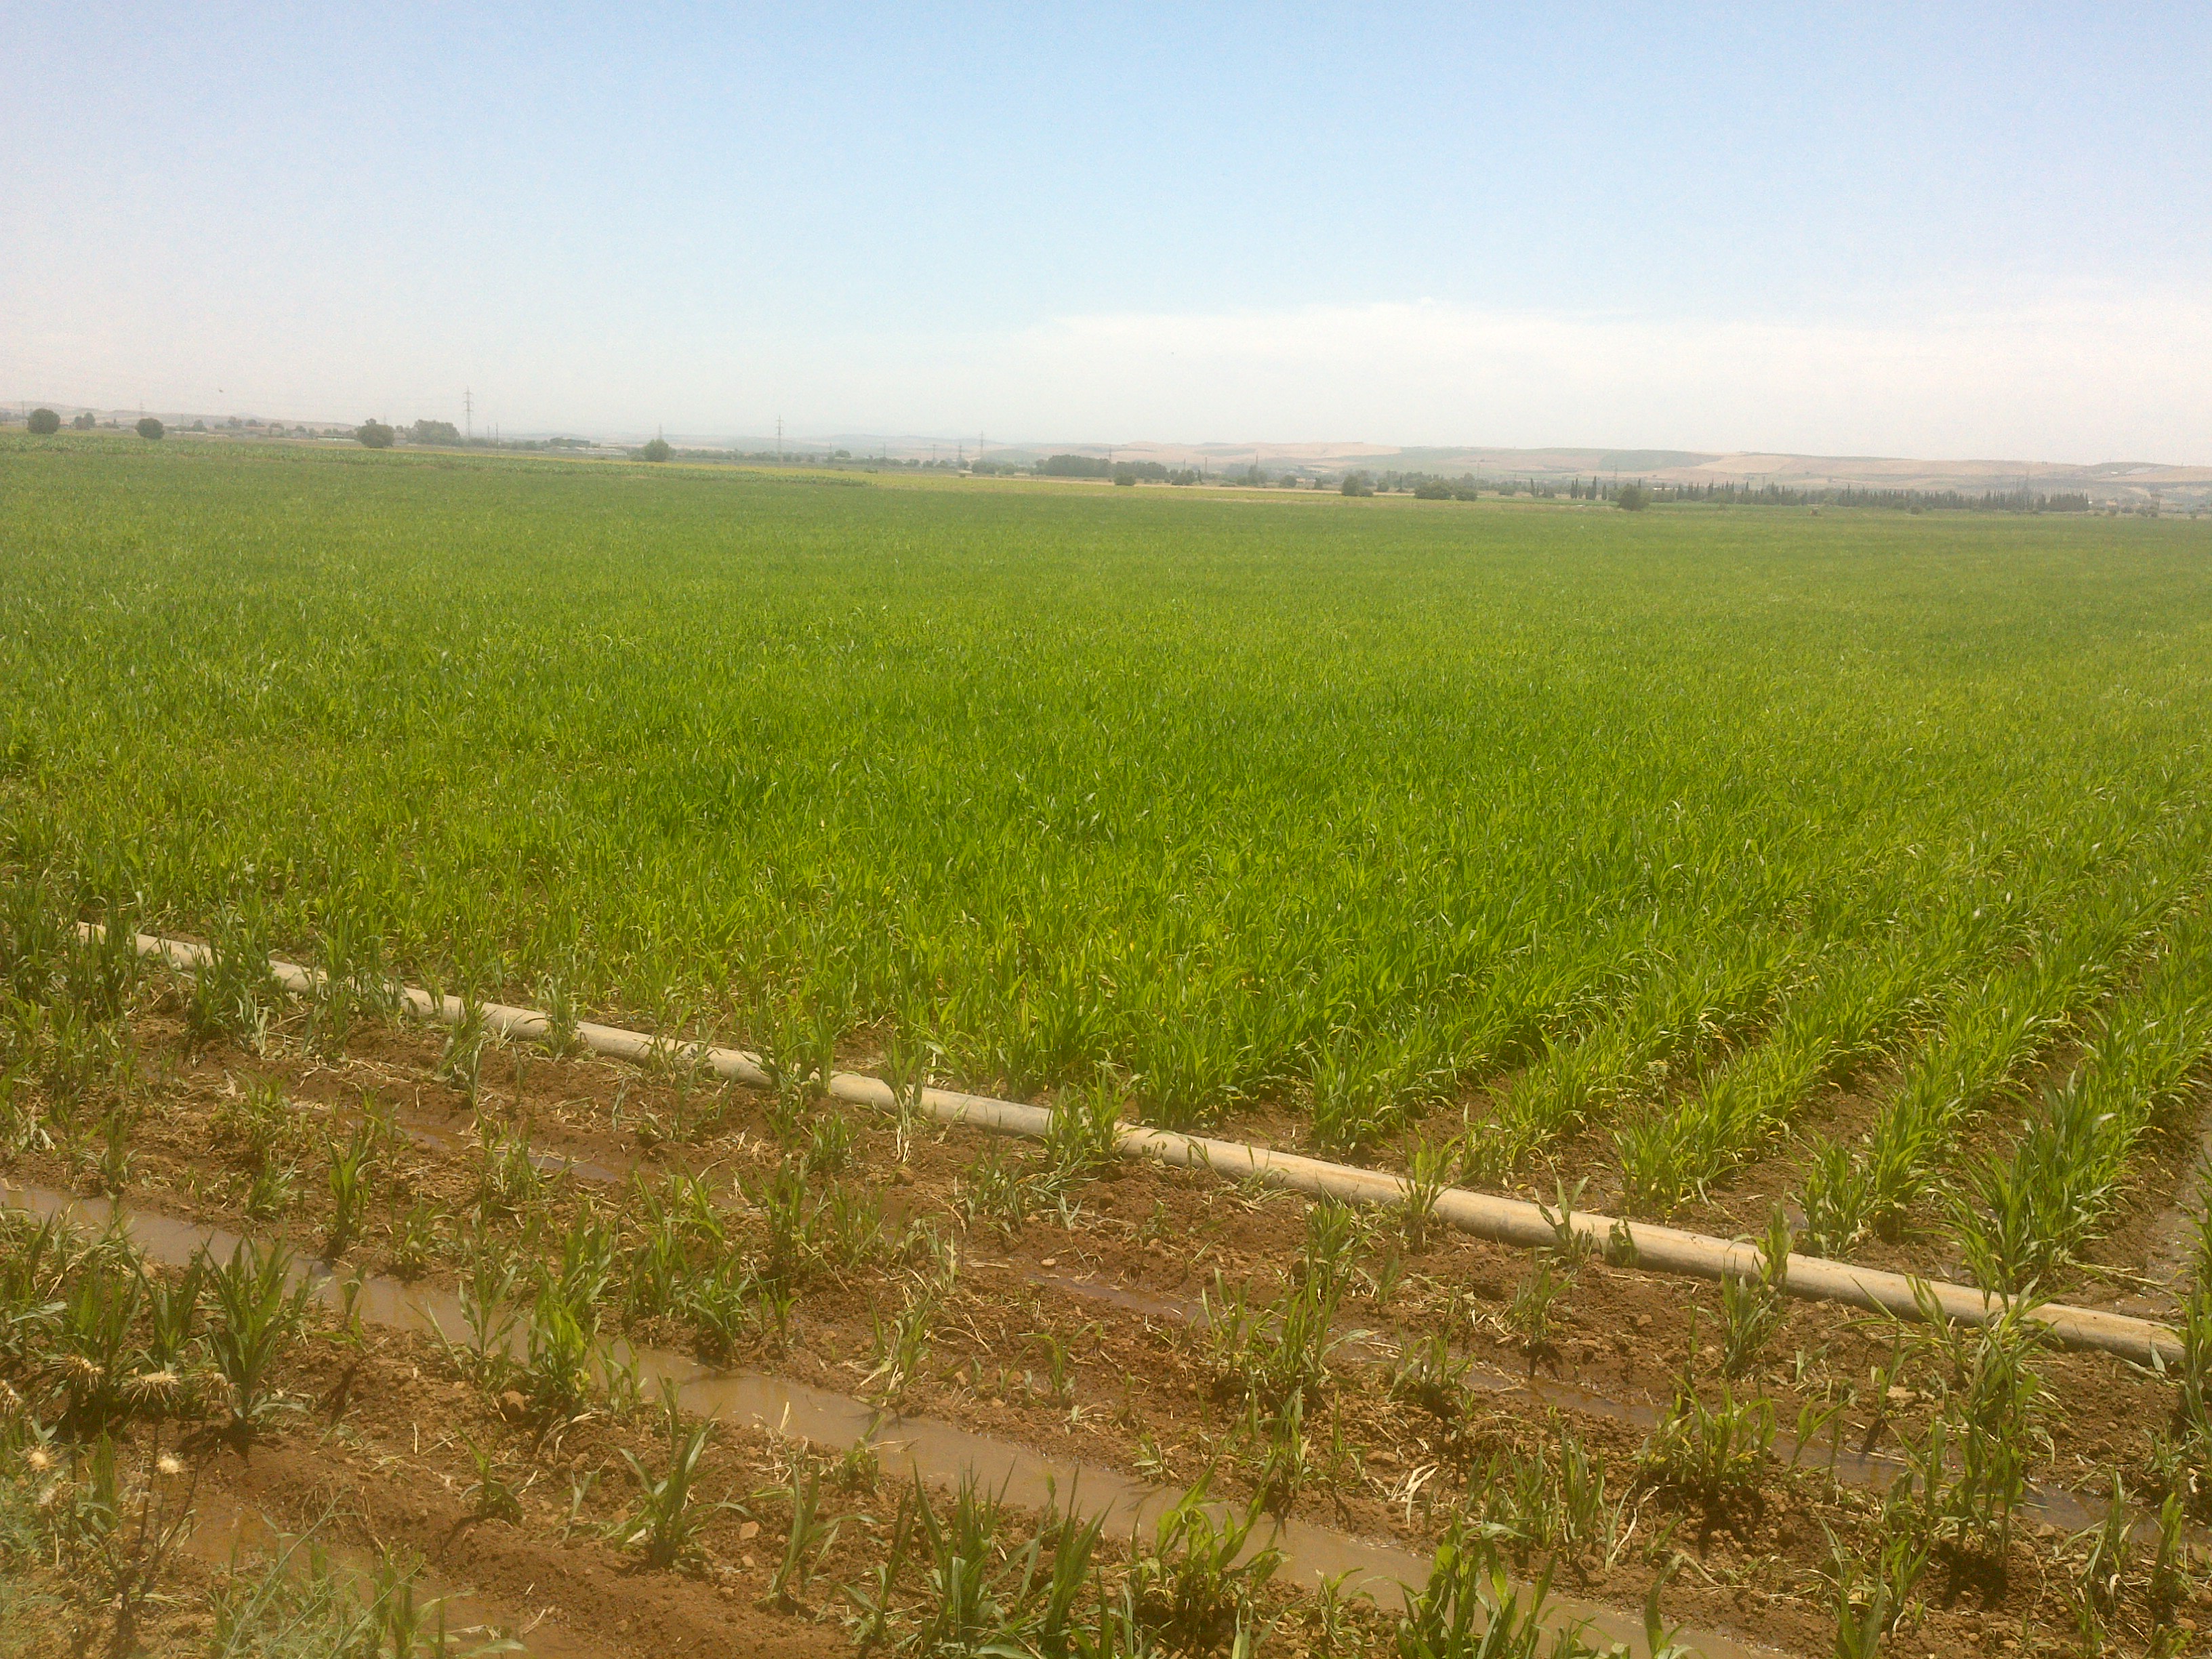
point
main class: Cropland
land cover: Maize
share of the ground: > 75 %
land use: Agriculture (excluding fallow land and kitchen gardens)
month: May
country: ES
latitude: 37.8697
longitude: -4.9193
